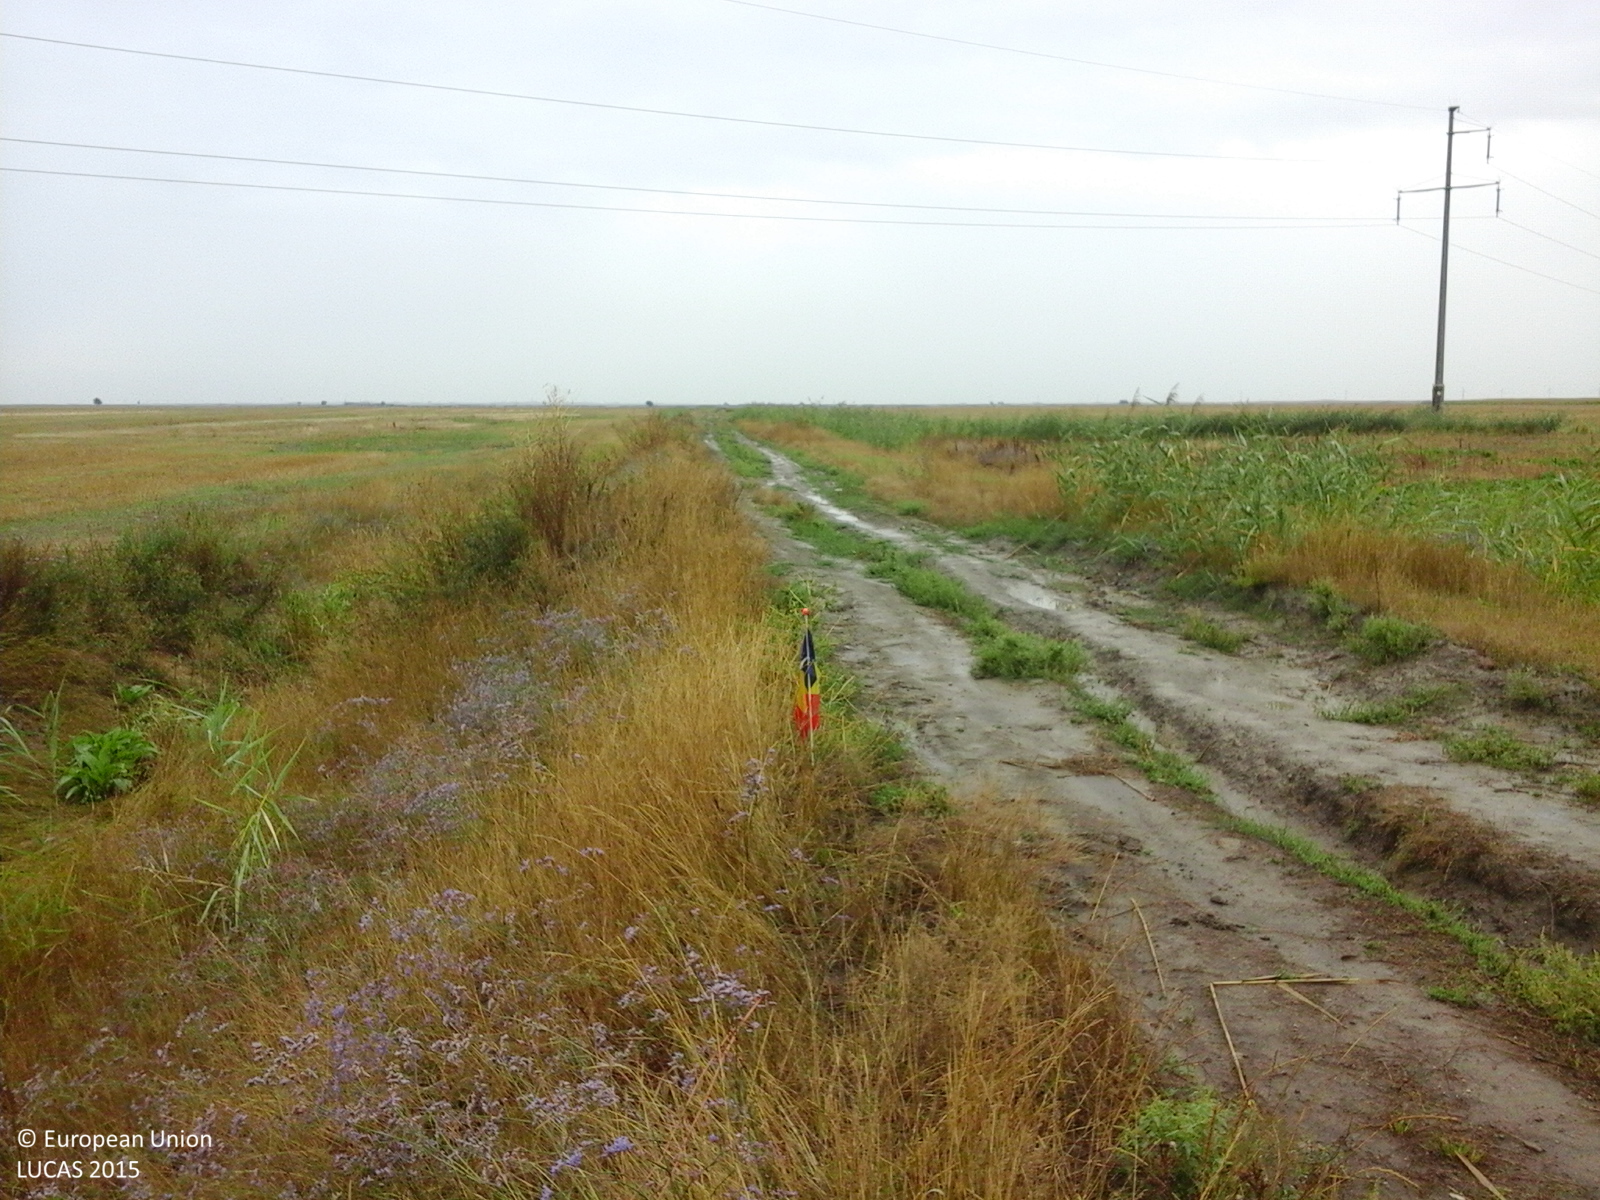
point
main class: Cropland
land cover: Common wheat
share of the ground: < 10 %
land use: Agriculture (excluding fallow land and kitchen gardens)
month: August
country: RO
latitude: 45.6015
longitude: 20.9888
